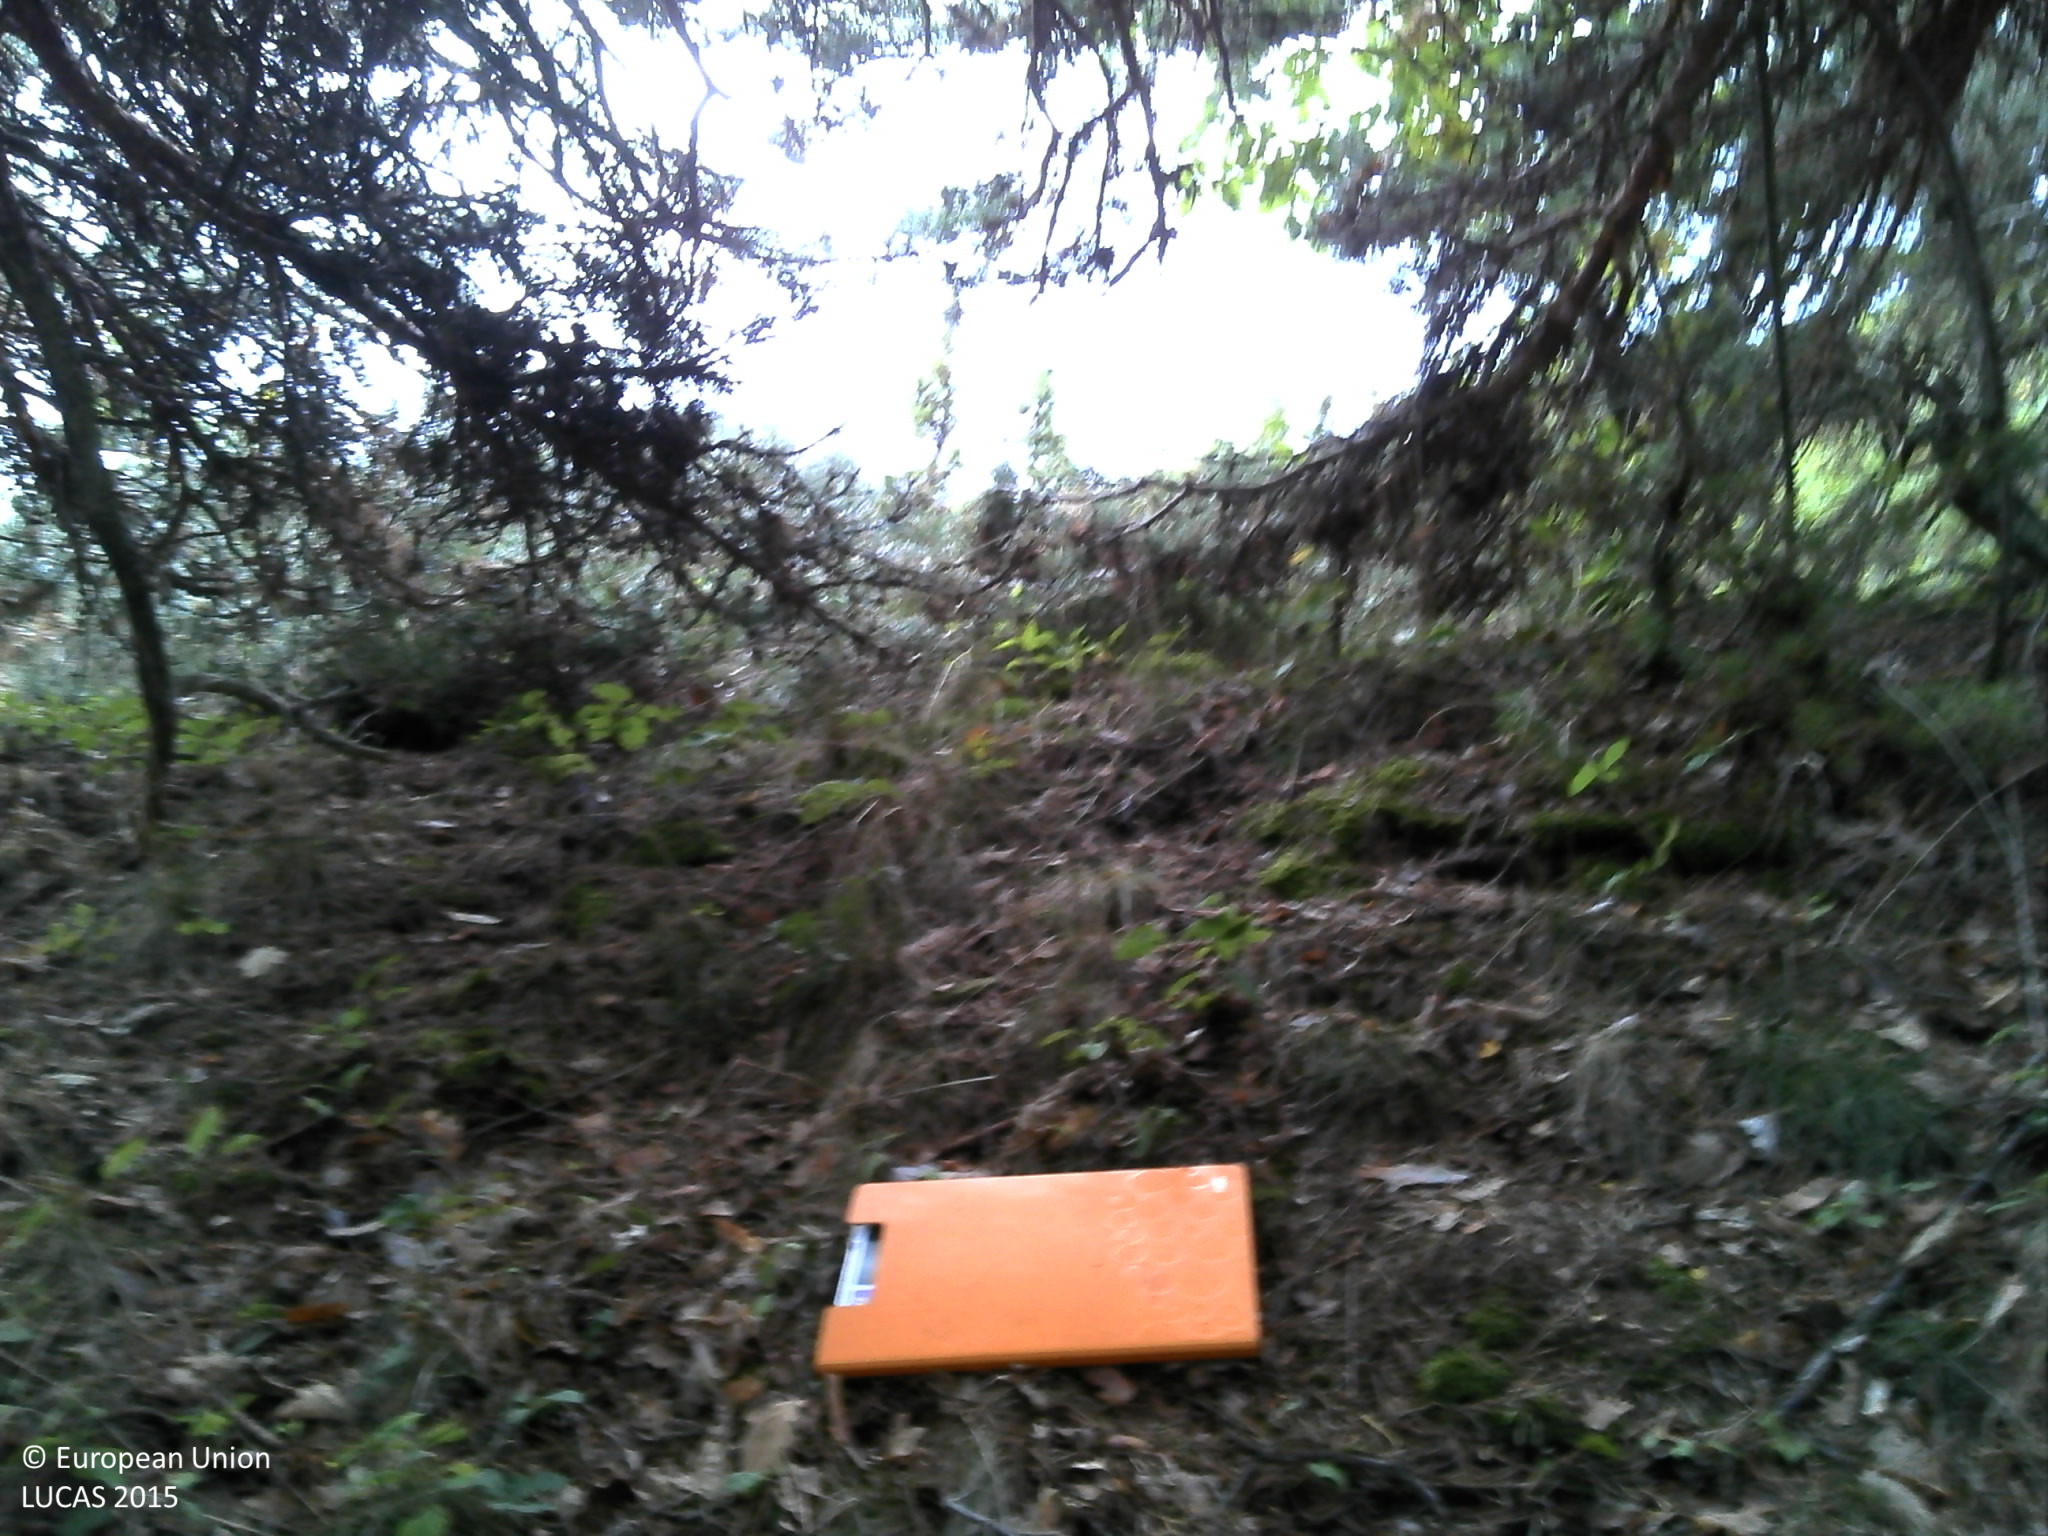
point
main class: Woodland
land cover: Pine dominated mixed woodland
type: alpine coniferous forest
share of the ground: > 75 %
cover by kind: coniferous forest trees 50 %, broadleaved forest trees 25 %, herbaceous plants 15 %, unconsolidated bare surface 10 %
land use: Forestry
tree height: > 5 m
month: October
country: FR
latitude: 45.4061
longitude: 3.1145
